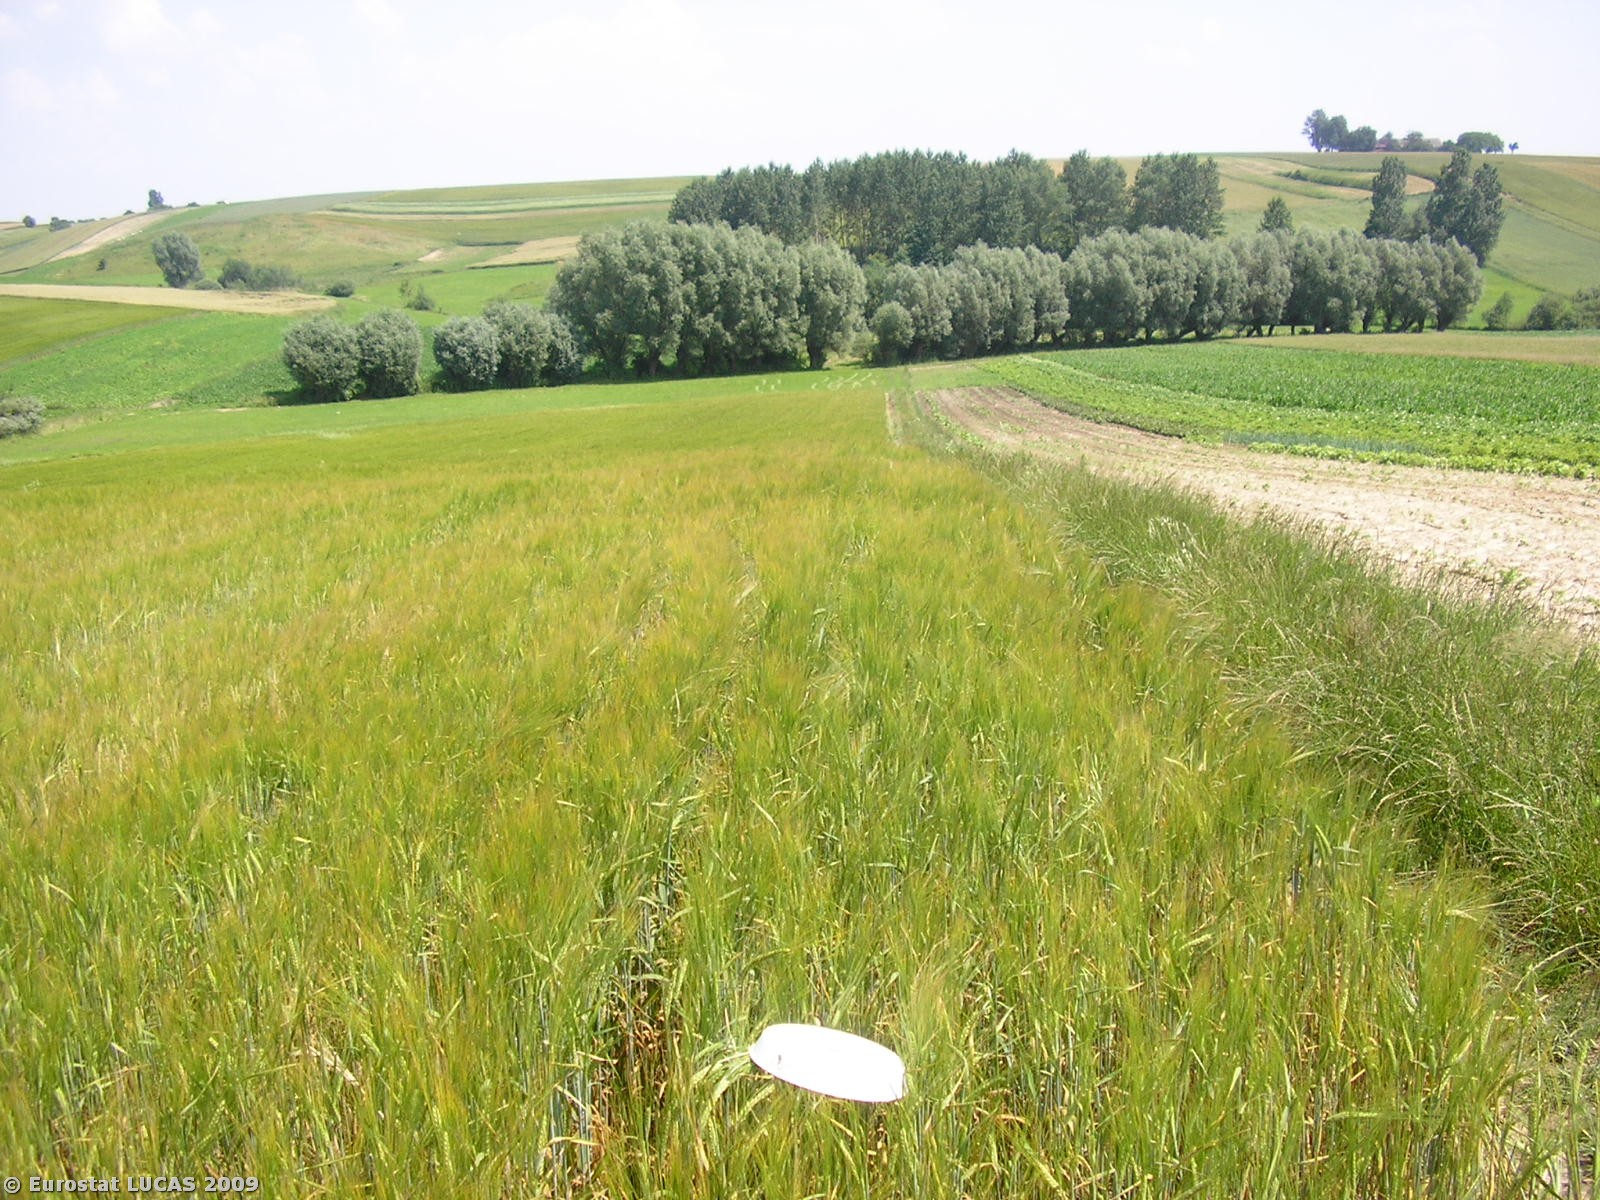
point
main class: Cropland
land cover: Barley
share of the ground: > 75 %
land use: Agriculture (excluding fallow land and kitchen gardens)
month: June
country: PL
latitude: 50.3782
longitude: 20.4005
